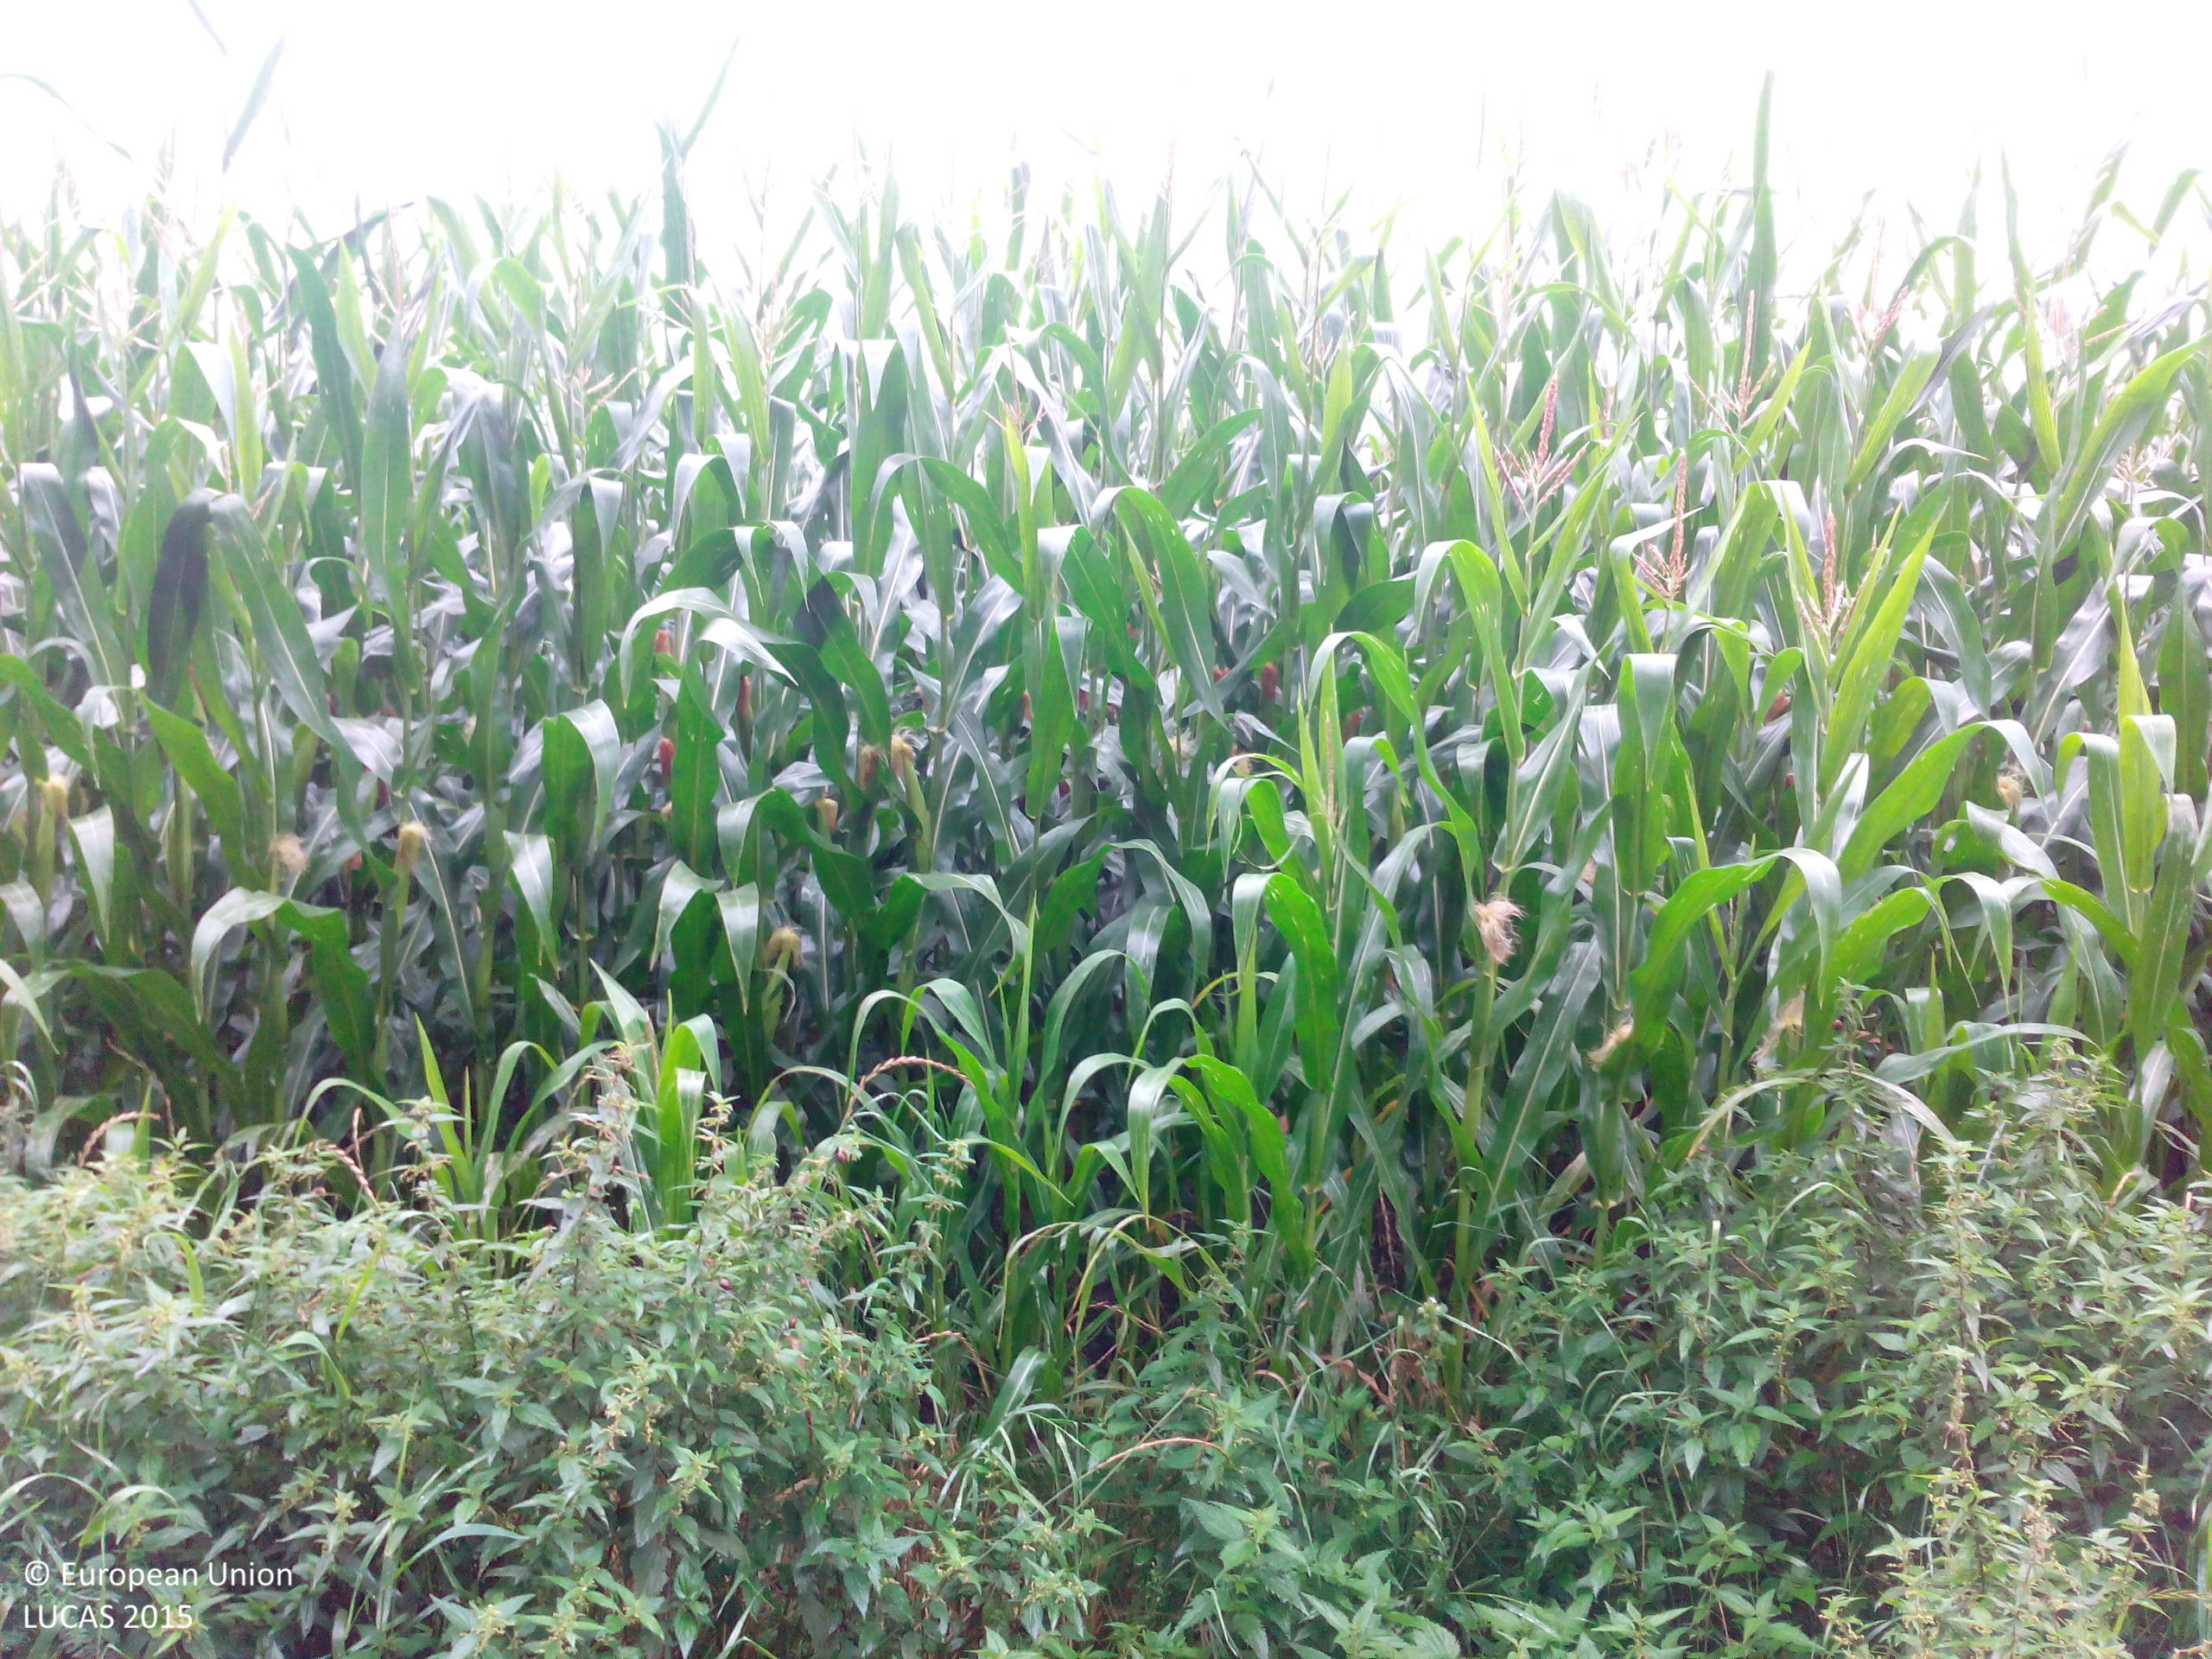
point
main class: Cropland
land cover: Maize
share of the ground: > 75 %
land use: Agriculture (excluding fallow land and kitchen gardens)
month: August
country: DE
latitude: 53.7613
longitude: 9.8939
